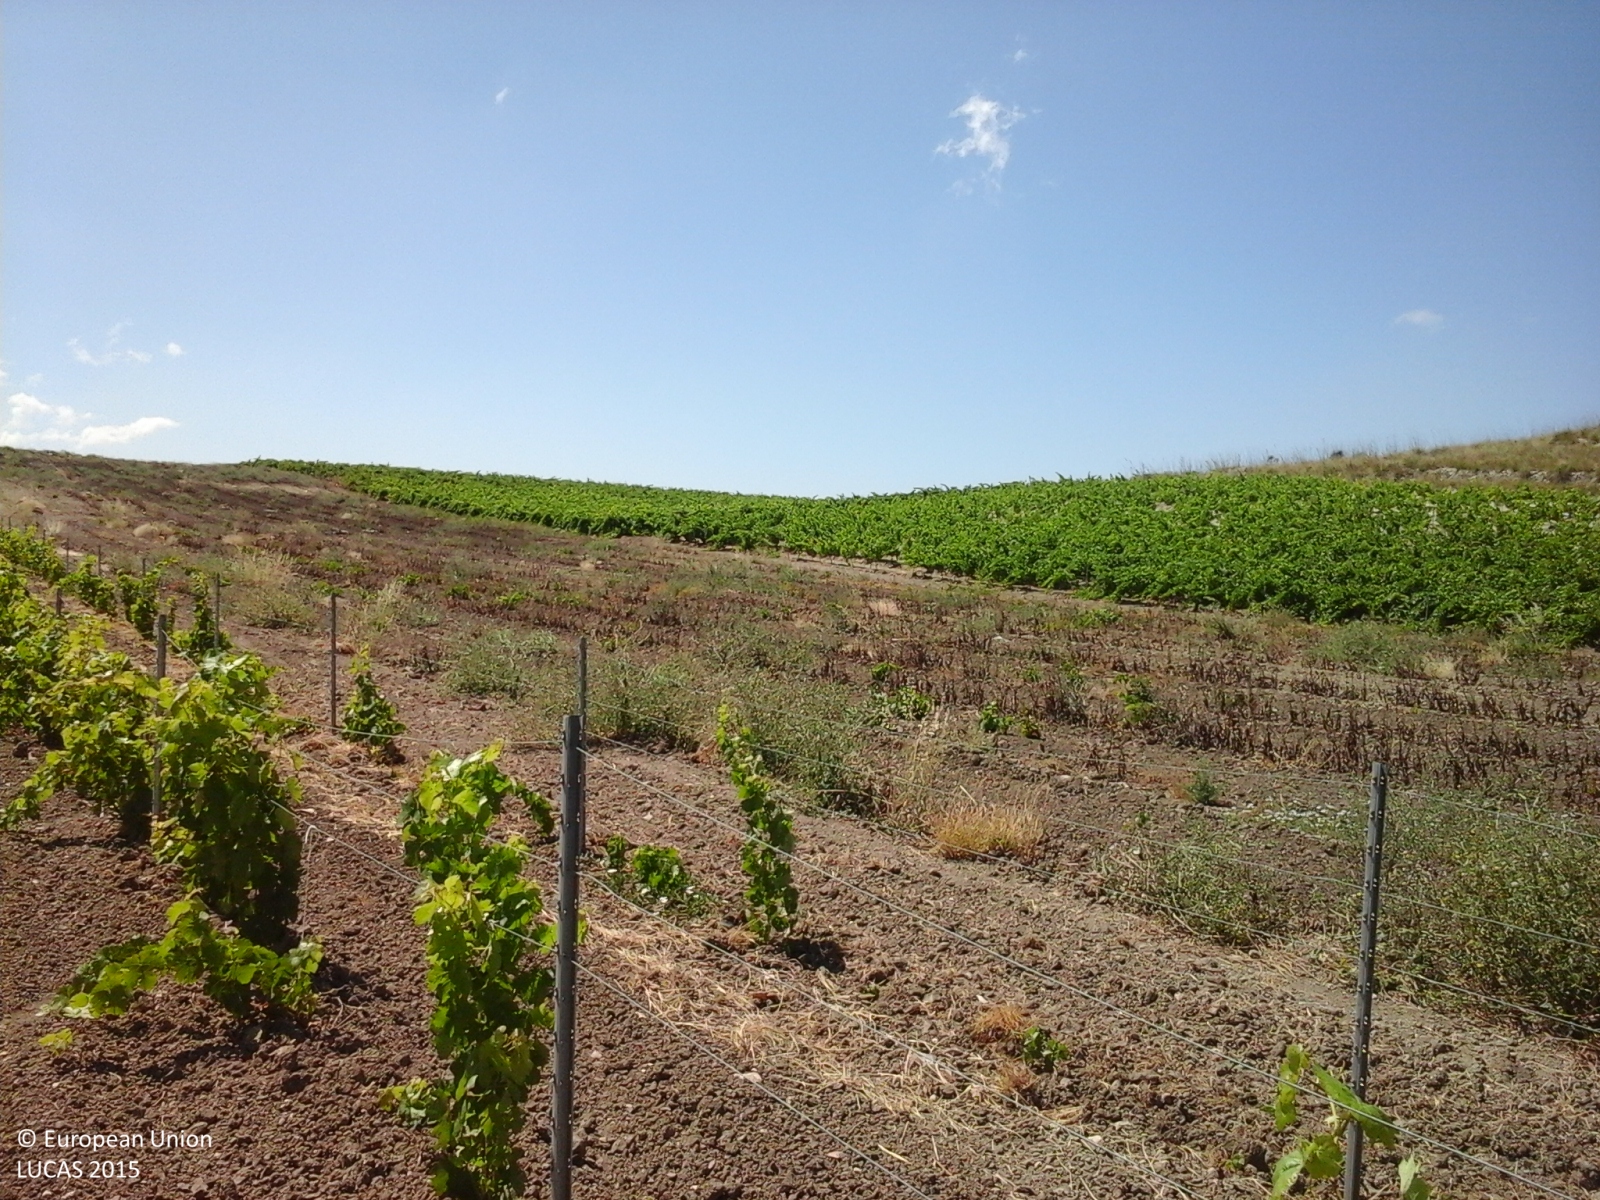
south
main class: Cropland
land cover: Vineyards
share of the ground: 25 - 50 %
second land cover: Other bare soil
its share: > 75 %
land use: Agriculture (excluding fallow land and kitchen gardens)
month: June
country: IT
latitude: 37.7276
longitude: 12.6915
